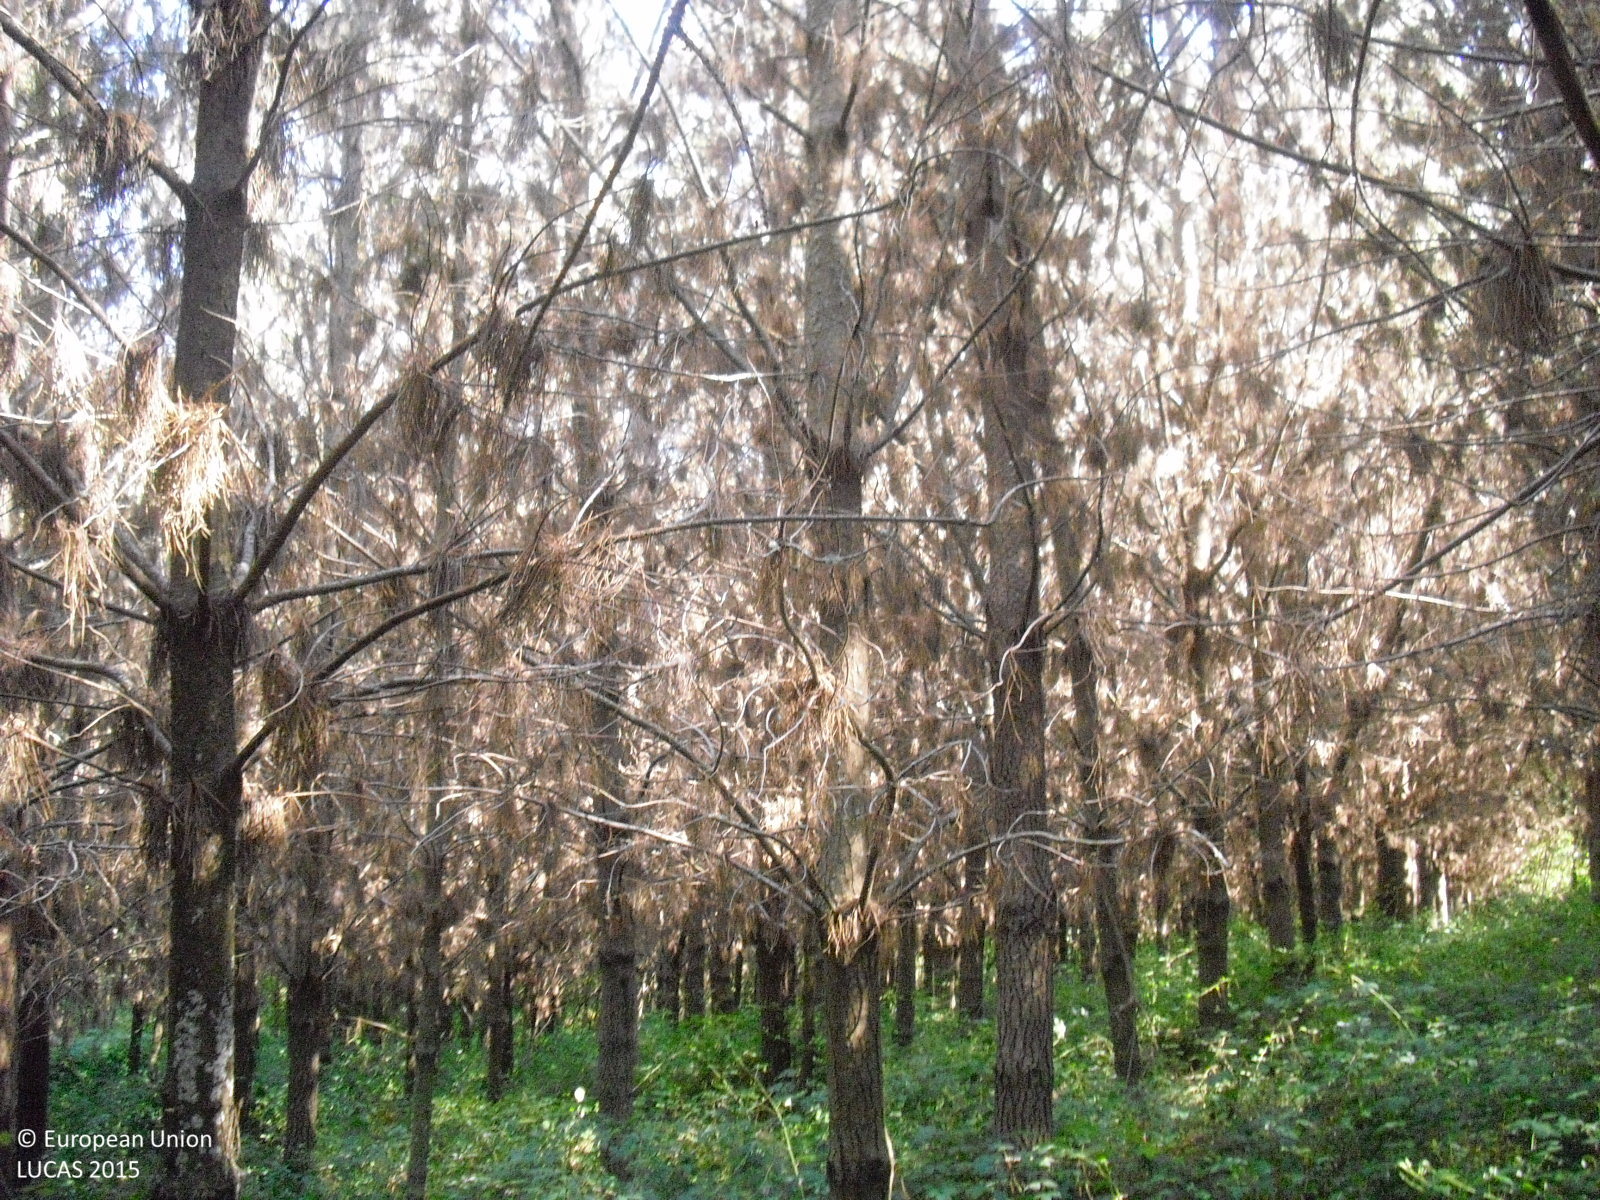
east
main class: Woodland
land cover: Pine dominated coniferous woodland
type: hemiboreal forest and nemoral coniferous forest and mixed broadleaved-coniferous forest
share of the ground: > 75 %
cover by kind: coniferous forest trees 100 %
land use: Forestry
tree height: > 5 m
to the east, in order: Pine dominated coniferous woodland; Rivers and streams; Broadleaved woodland; Pine dominated mixed woodland; Broadleaved woodland
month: July
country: ES
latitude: 42.6639
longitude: -7.5058
